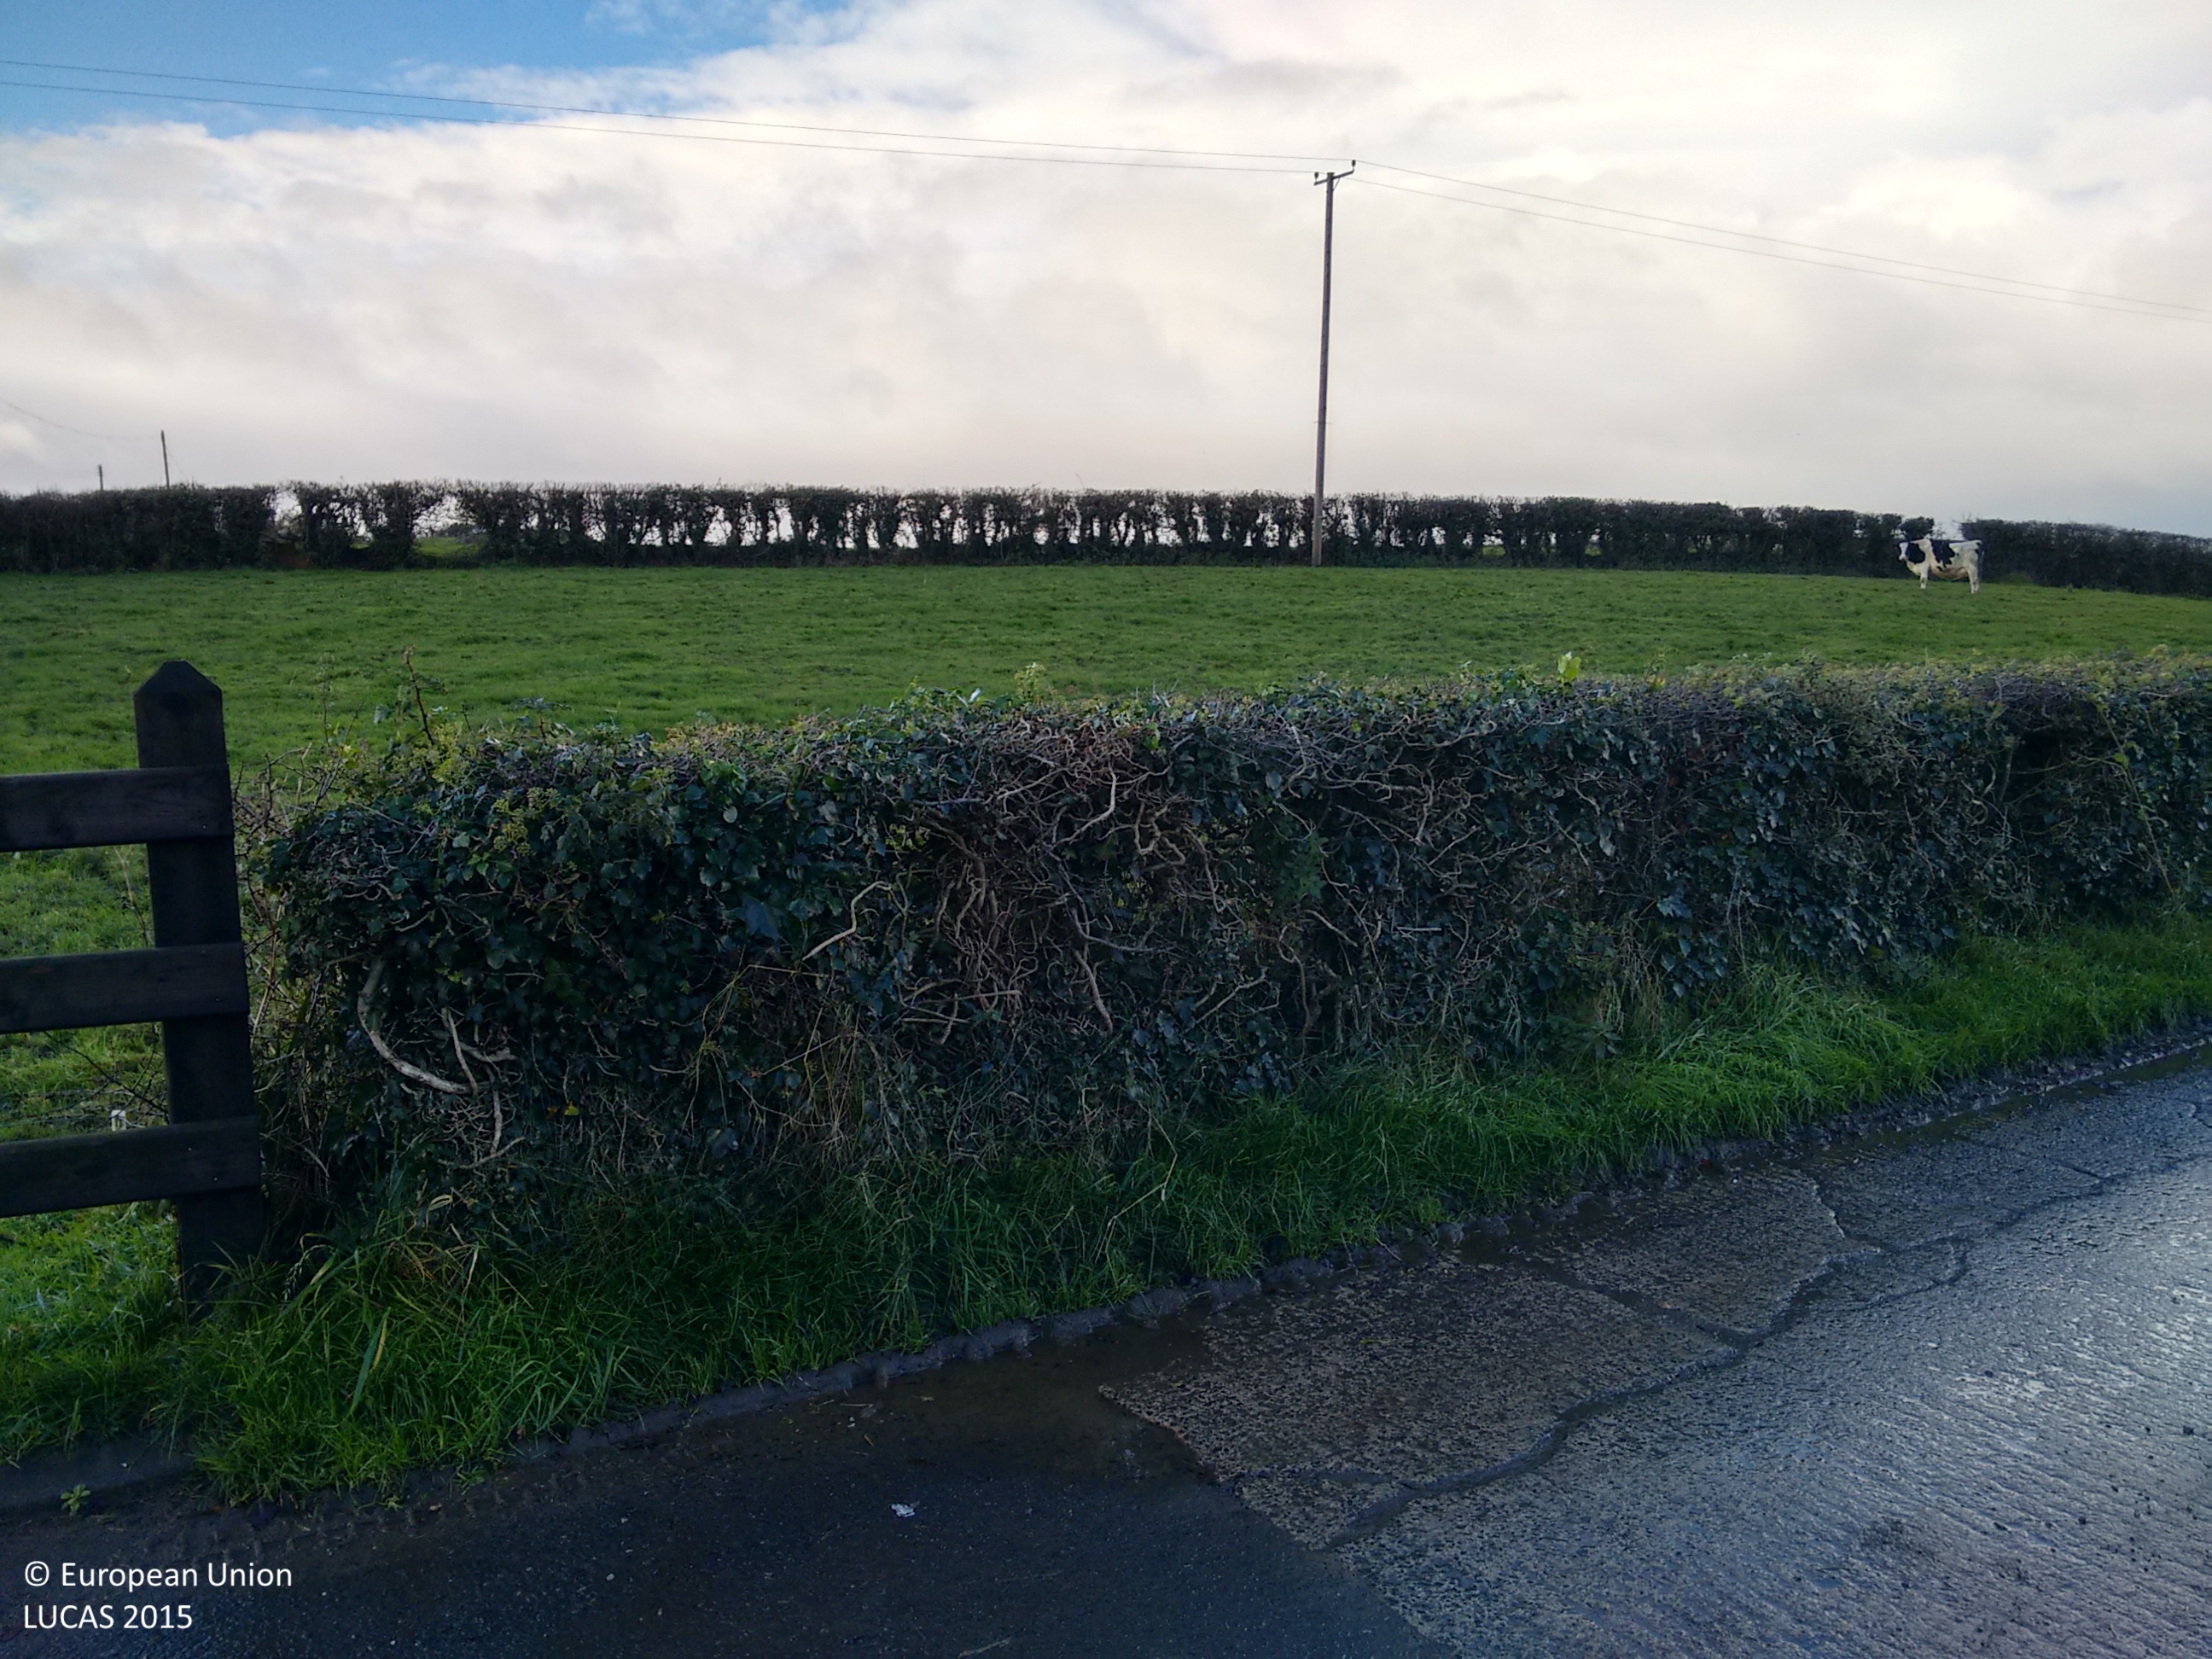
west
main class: Grassland
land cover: Grassland without tree/shrub cover
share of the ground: > 75 %
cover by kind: herbaceous plants 100 %
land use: Agriculture (excluding fallow land and kitchen gardens)
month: November
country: GB
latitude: 54.5842
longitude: -5.5873
